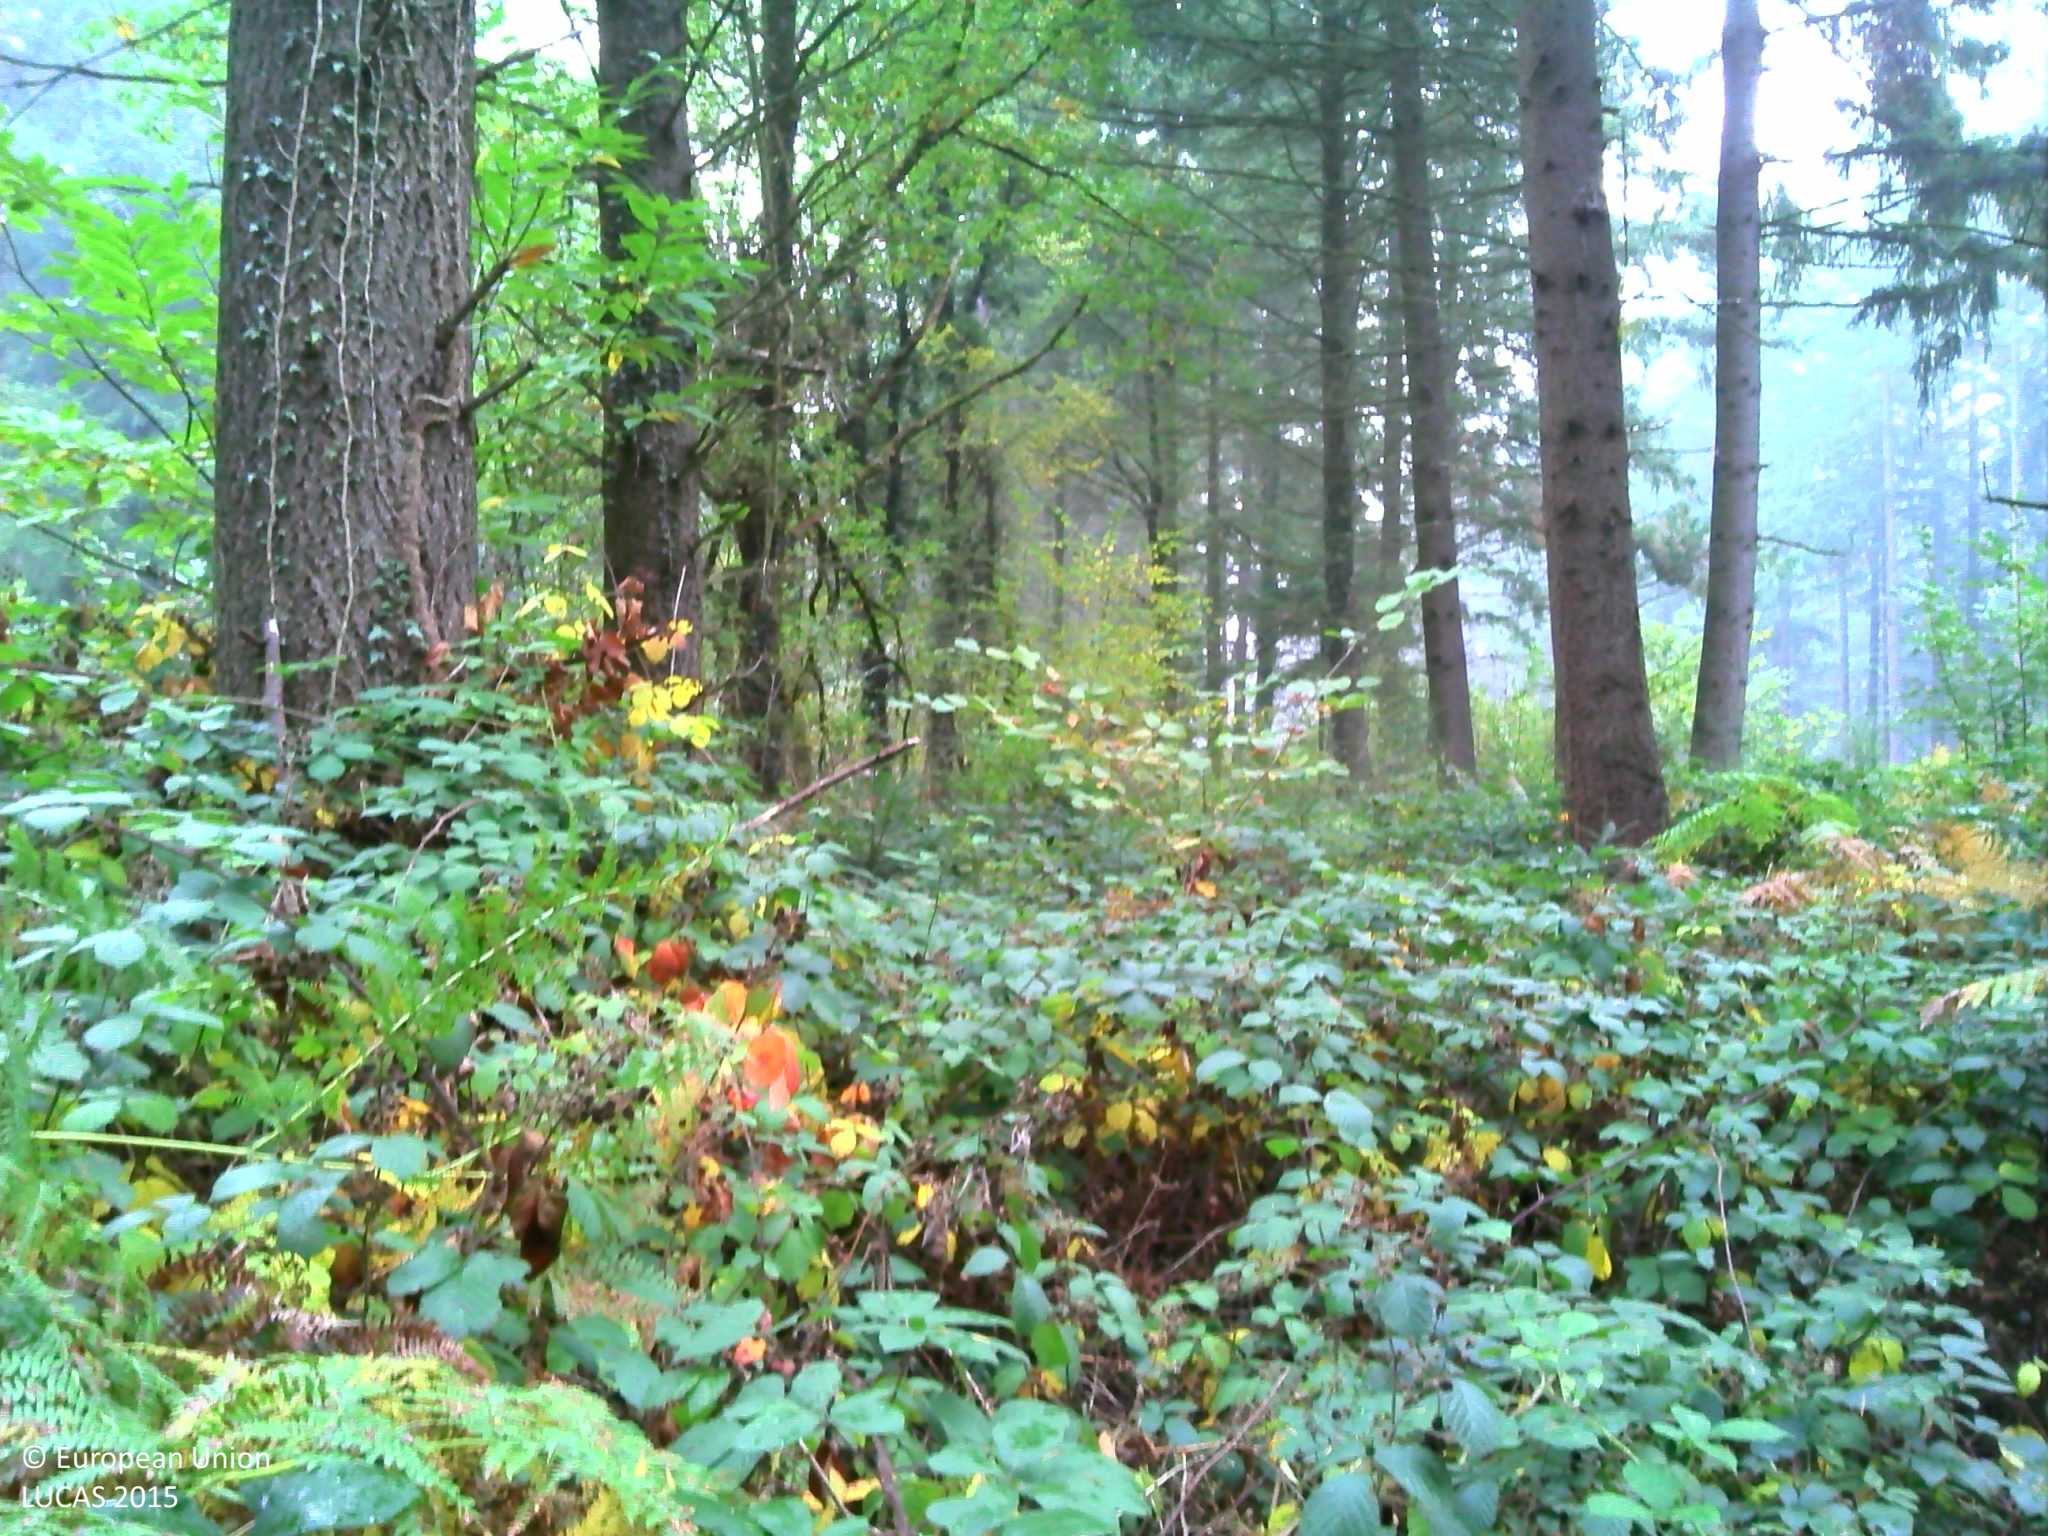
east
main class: Woodland
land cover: Other coniferous woodland
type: exotic forest
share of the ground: 50 - 75 %
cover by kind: coniferous forest trees 65 %, shrubs 20 %, broadleaved forest trees 5 %, herbaceous plants 5 %, lichens and mosses 5 %
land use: Forestry
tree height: > 5 m
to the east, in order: Other coniferous woodland; Other bare soil; Other coniferous woodland
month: October
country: FR
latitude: 46.1974
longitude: 2.7793
